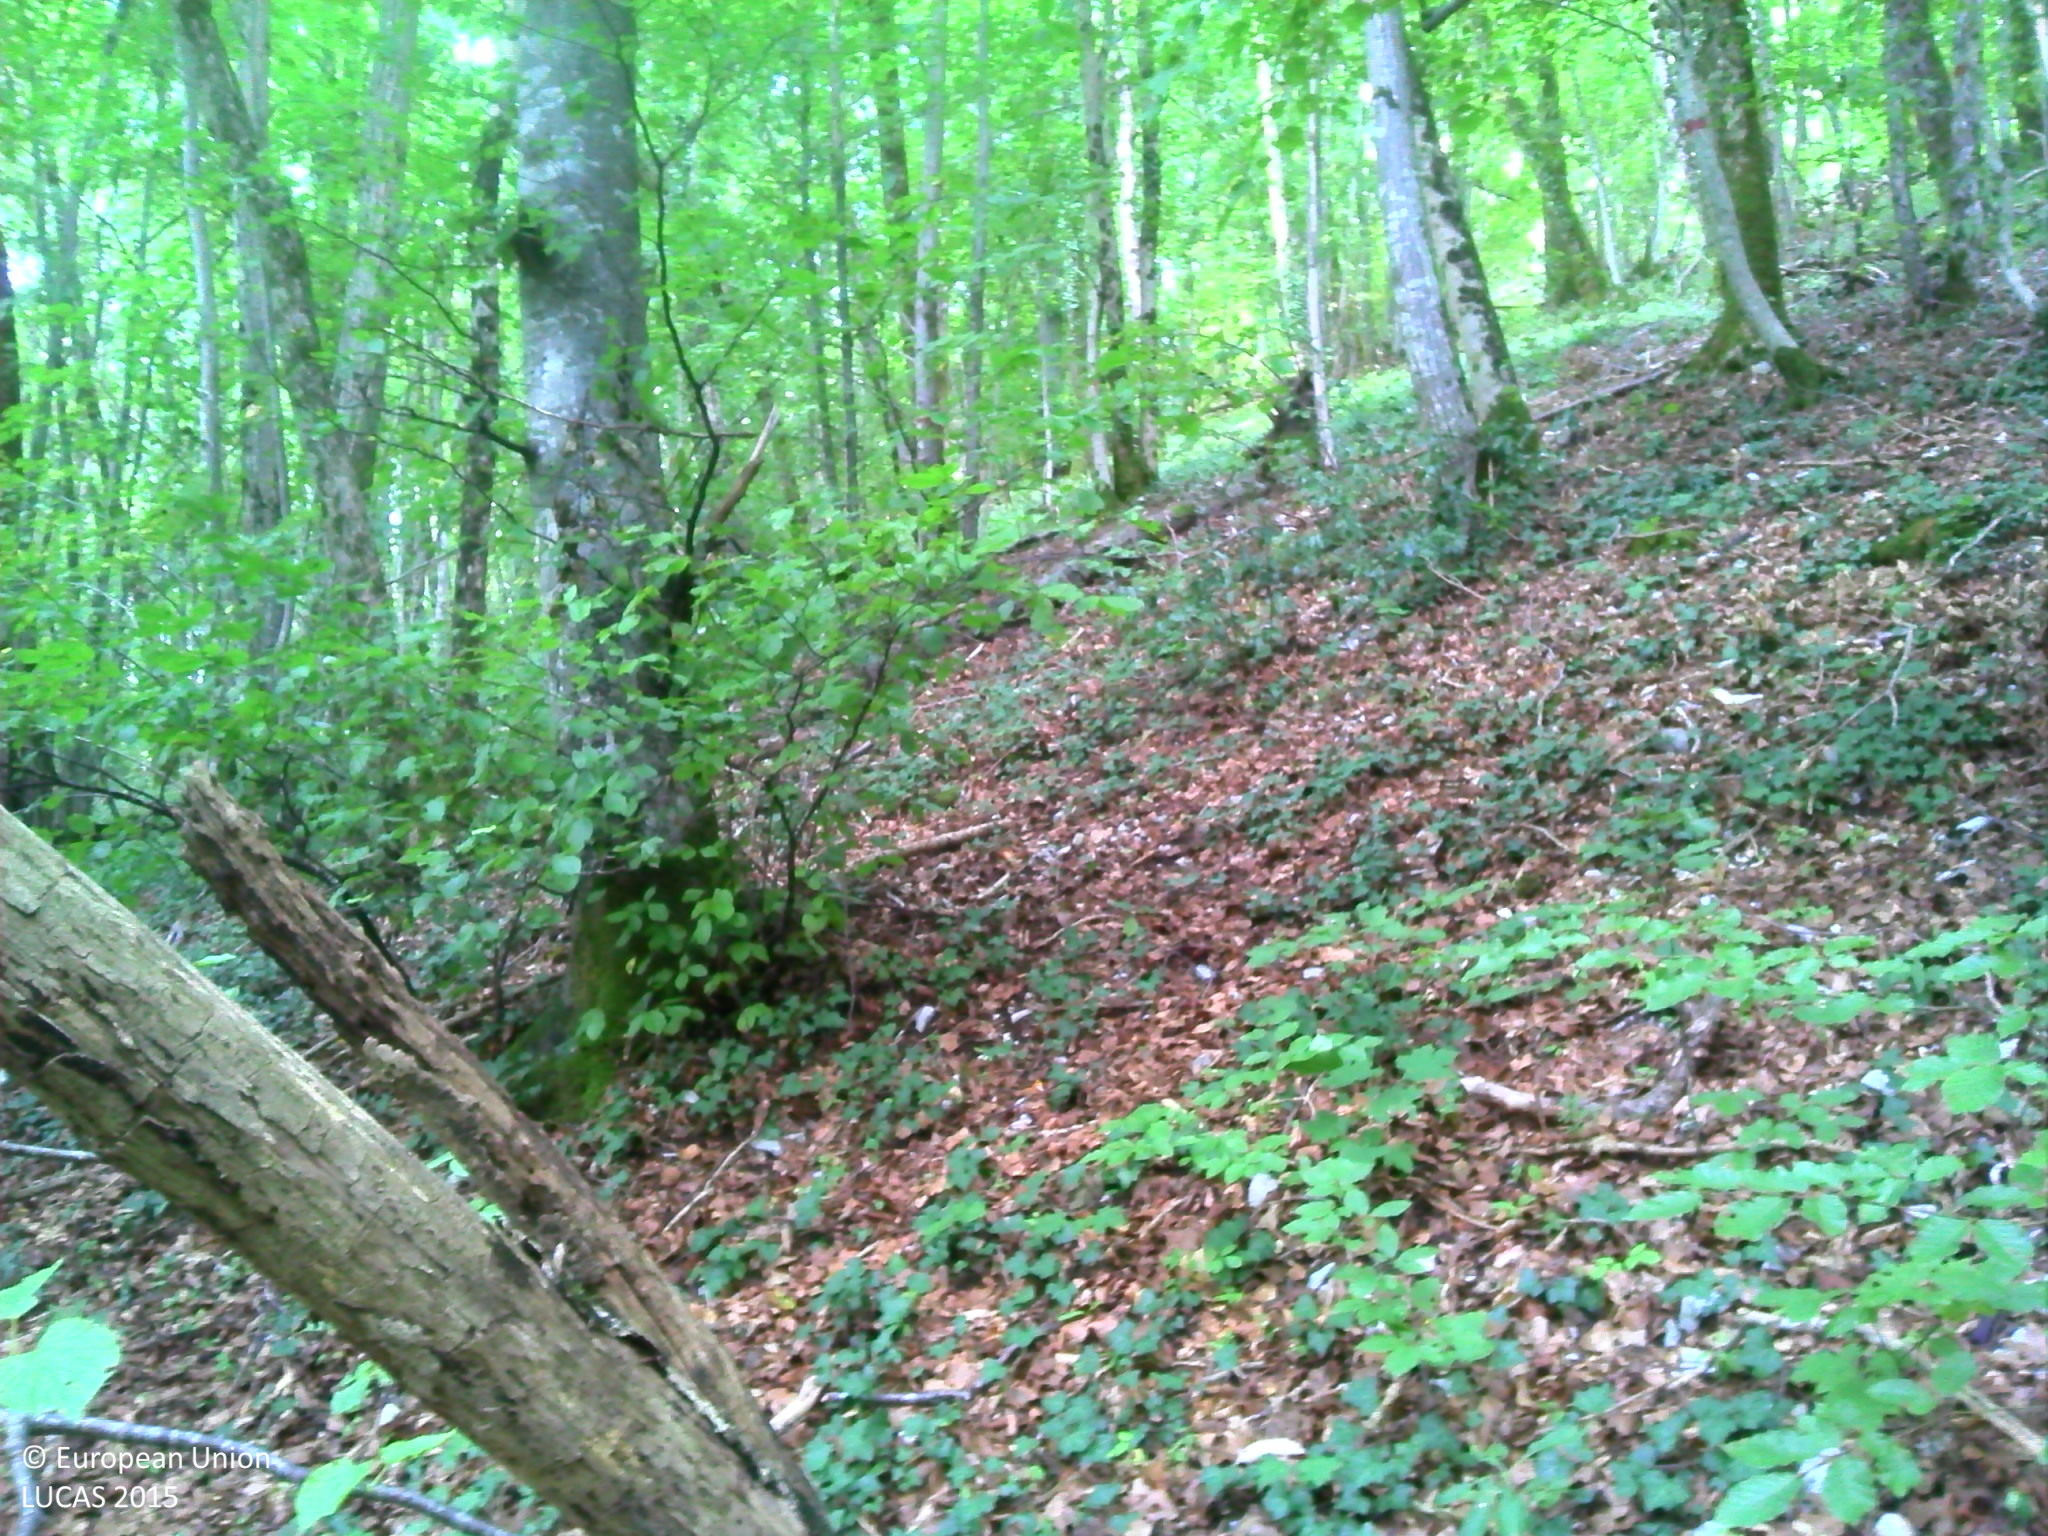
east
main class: Woodland
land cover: Broadleaved woodland
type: beech forest
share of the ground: > 75 %
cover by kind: broadleaved forest trees 100 %
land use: Forestry
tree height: > 5 m
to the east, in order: Broadleaved woodland; Rock outcrops; Broadleaved woodland
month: September
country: FR
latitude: 47.4615
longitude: 6.3801
